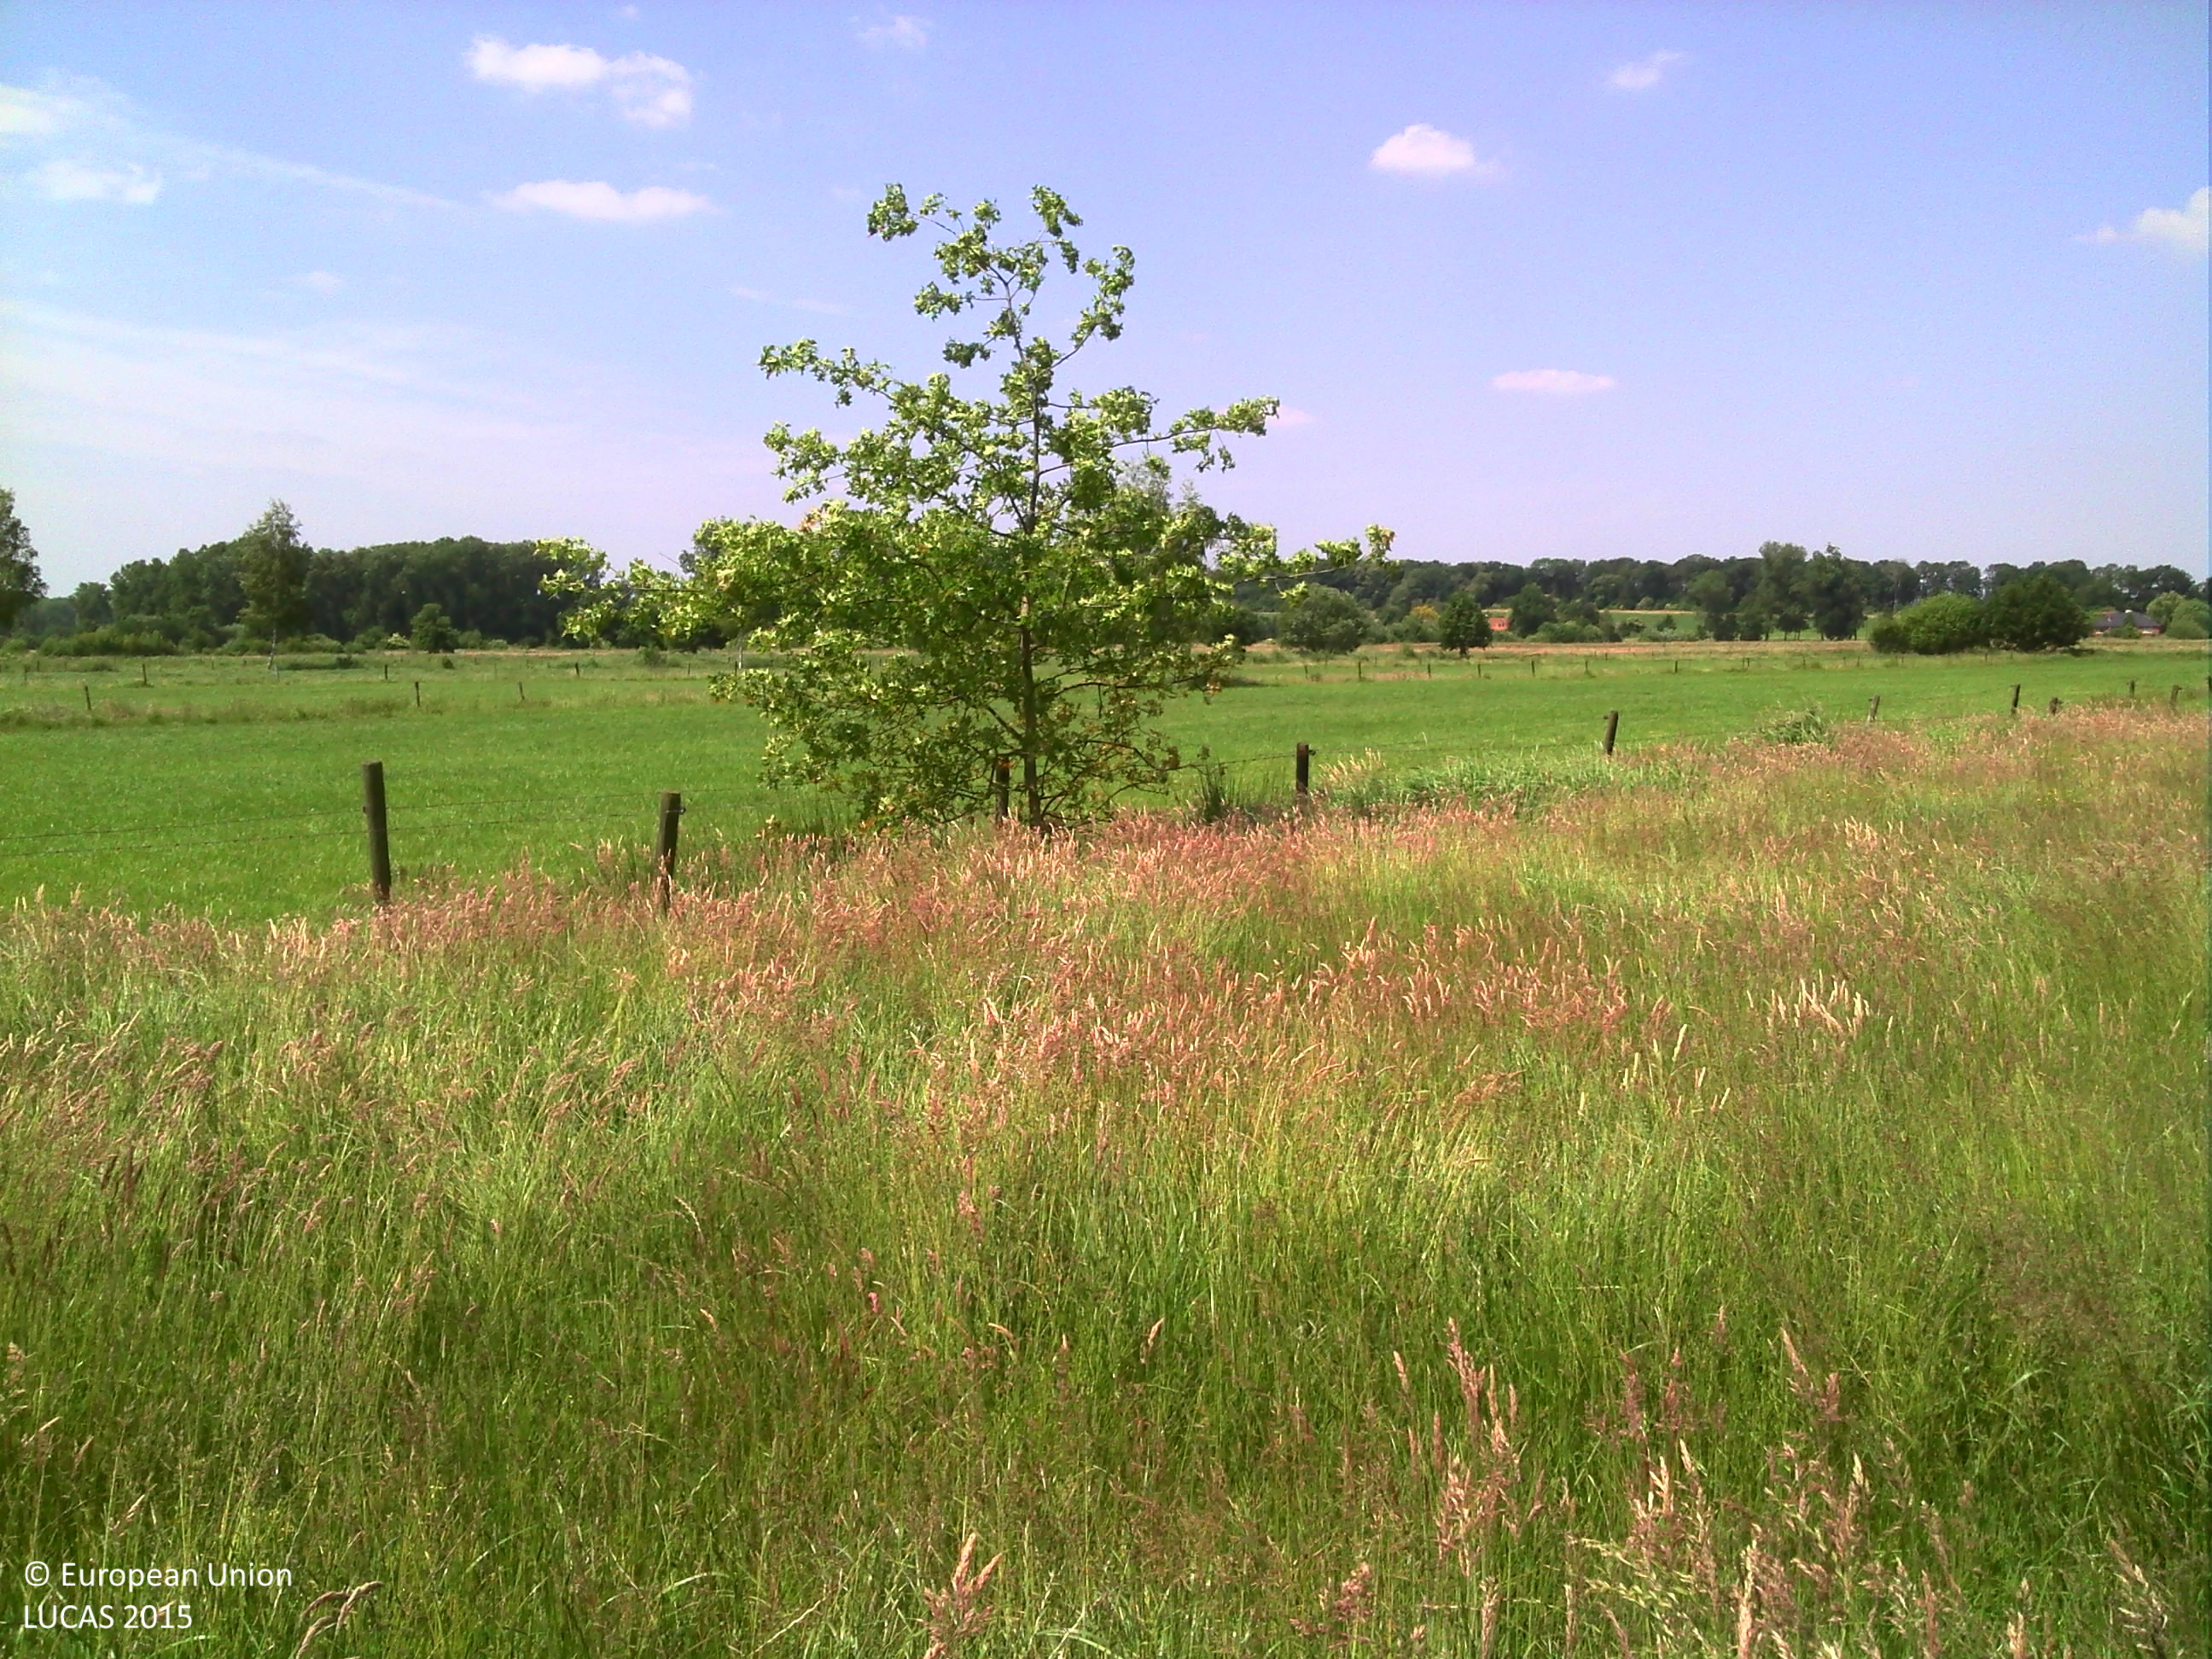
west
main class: Grassland
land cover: Grassland without tree/shrub cover
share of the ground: > 75 %
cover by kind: herbaceous plants 100 %
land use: Agriculture (excluding fallow land and kitchen gardens)
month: June
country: BE
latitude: 51.0005
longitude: 5.1668
